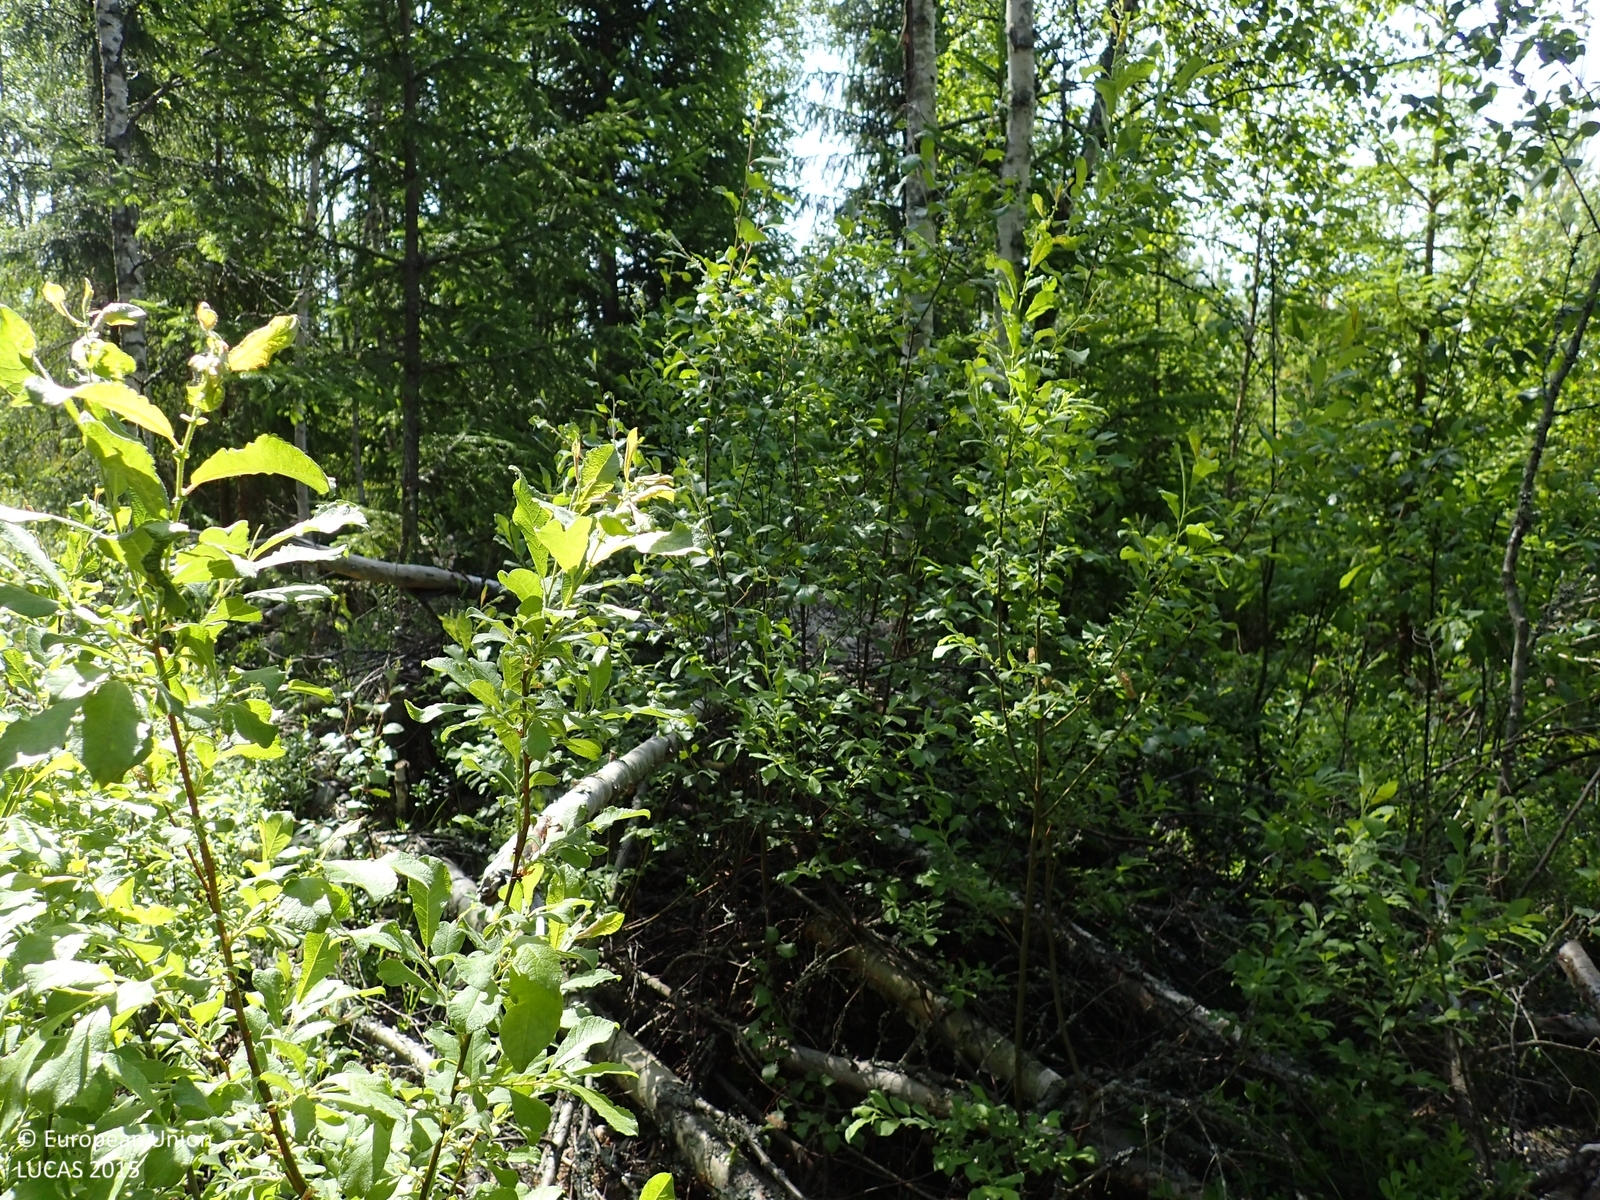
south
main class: Woodland
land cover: Spruce dominated mixed woodland
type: boreal forest
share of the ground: > 75 %
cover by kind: coniferous forest trees 45 %, broadleaved forest trees 40 %, shrubs 10 %, herbaceous plants 5 %
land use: Forestry
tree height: > 5 m
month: July
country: FI
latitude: 62.7726
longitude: 21.5023
